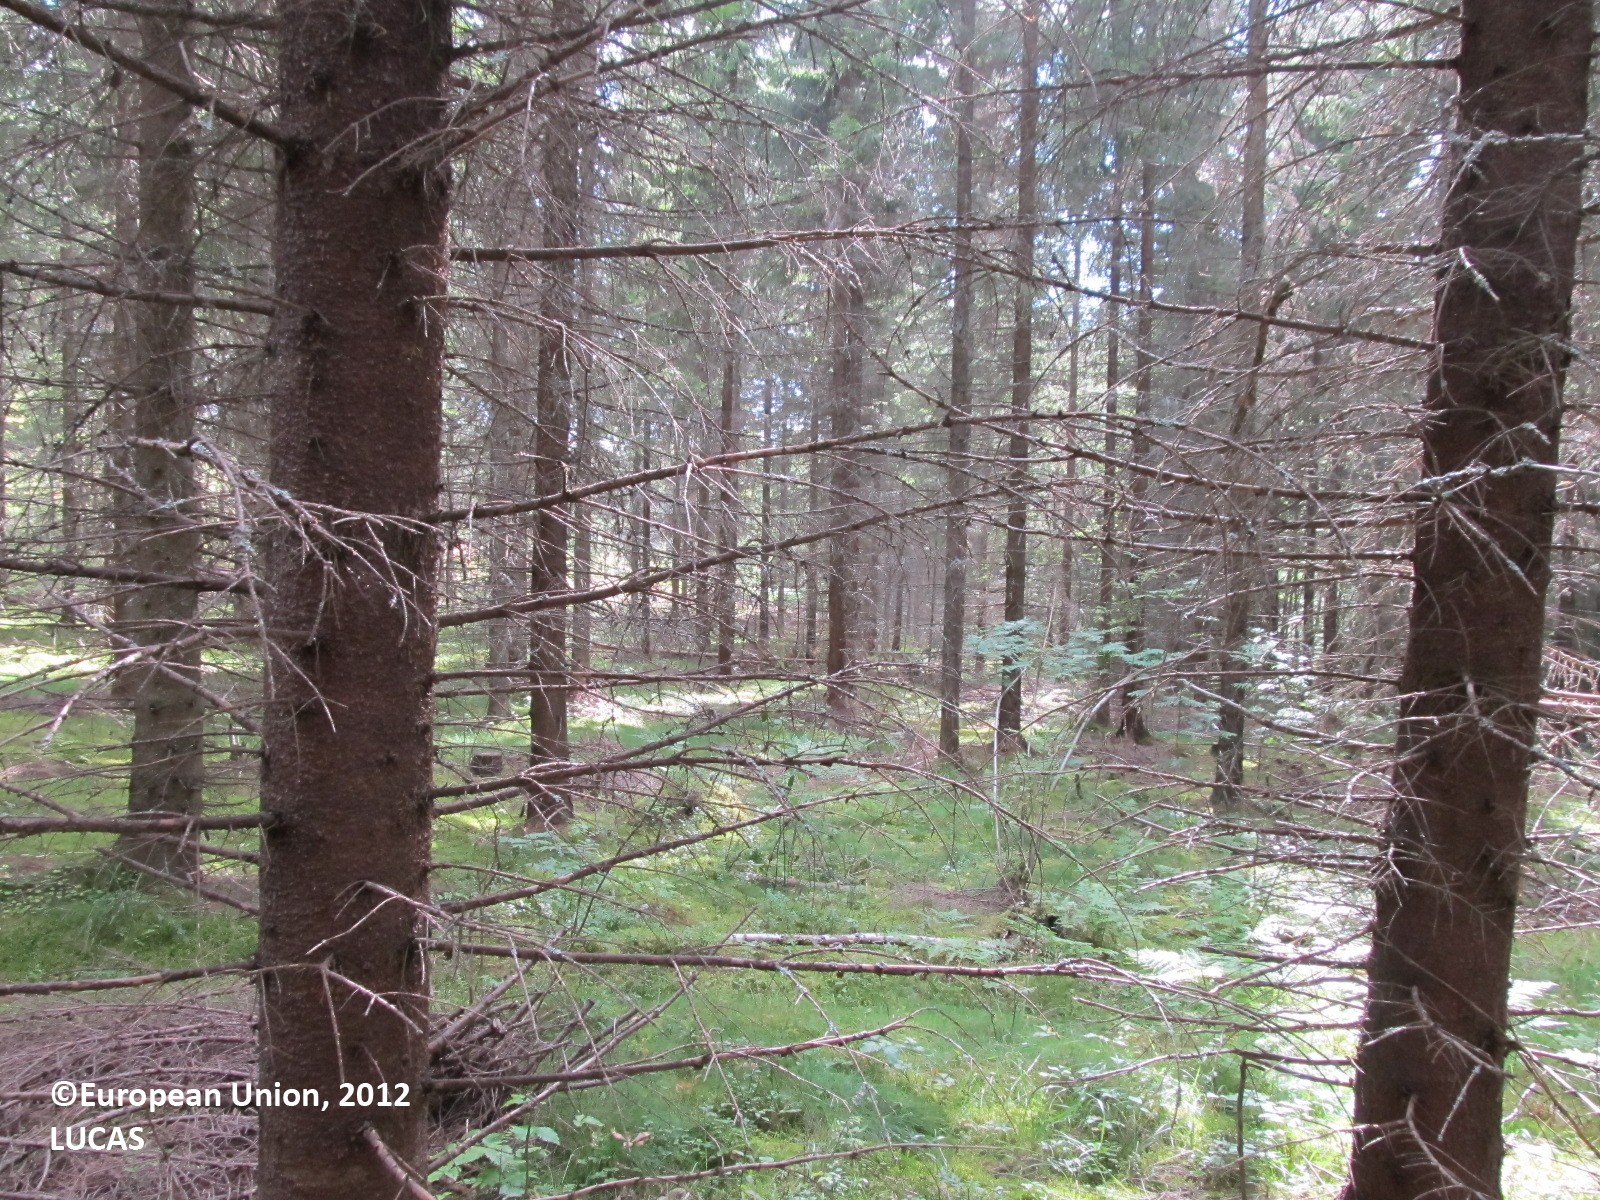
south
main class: Woodland
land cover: Spruce dominated coniferous woodland
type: boreal forest
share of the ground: 50 - 75 %
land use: Forestry
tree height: > 5 m
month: August
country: FI
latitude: 61.6625
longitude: 27.6888
